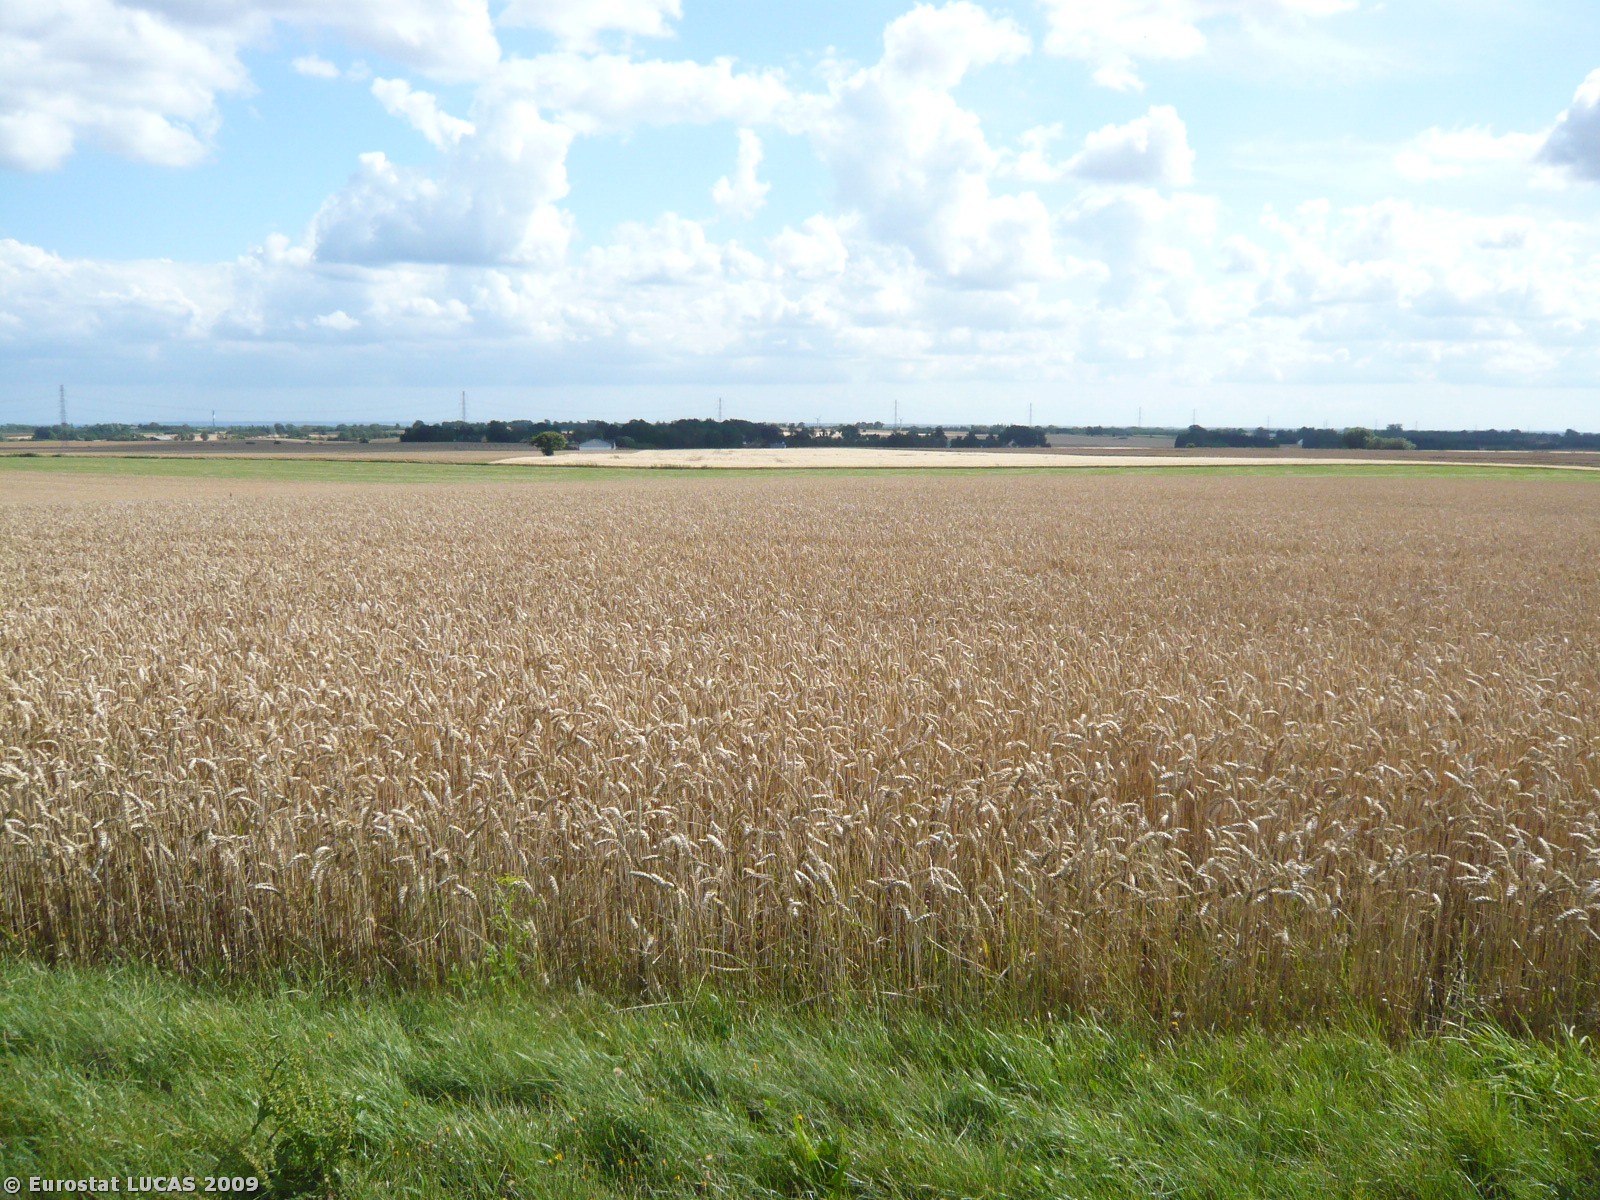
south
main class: Cropland
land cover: Common wheat
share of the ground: > 75 %
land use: Agriculture (excluding fallow land and kitchen gardens)
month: July
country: DK
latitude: 55.5760
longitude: 12.1712
